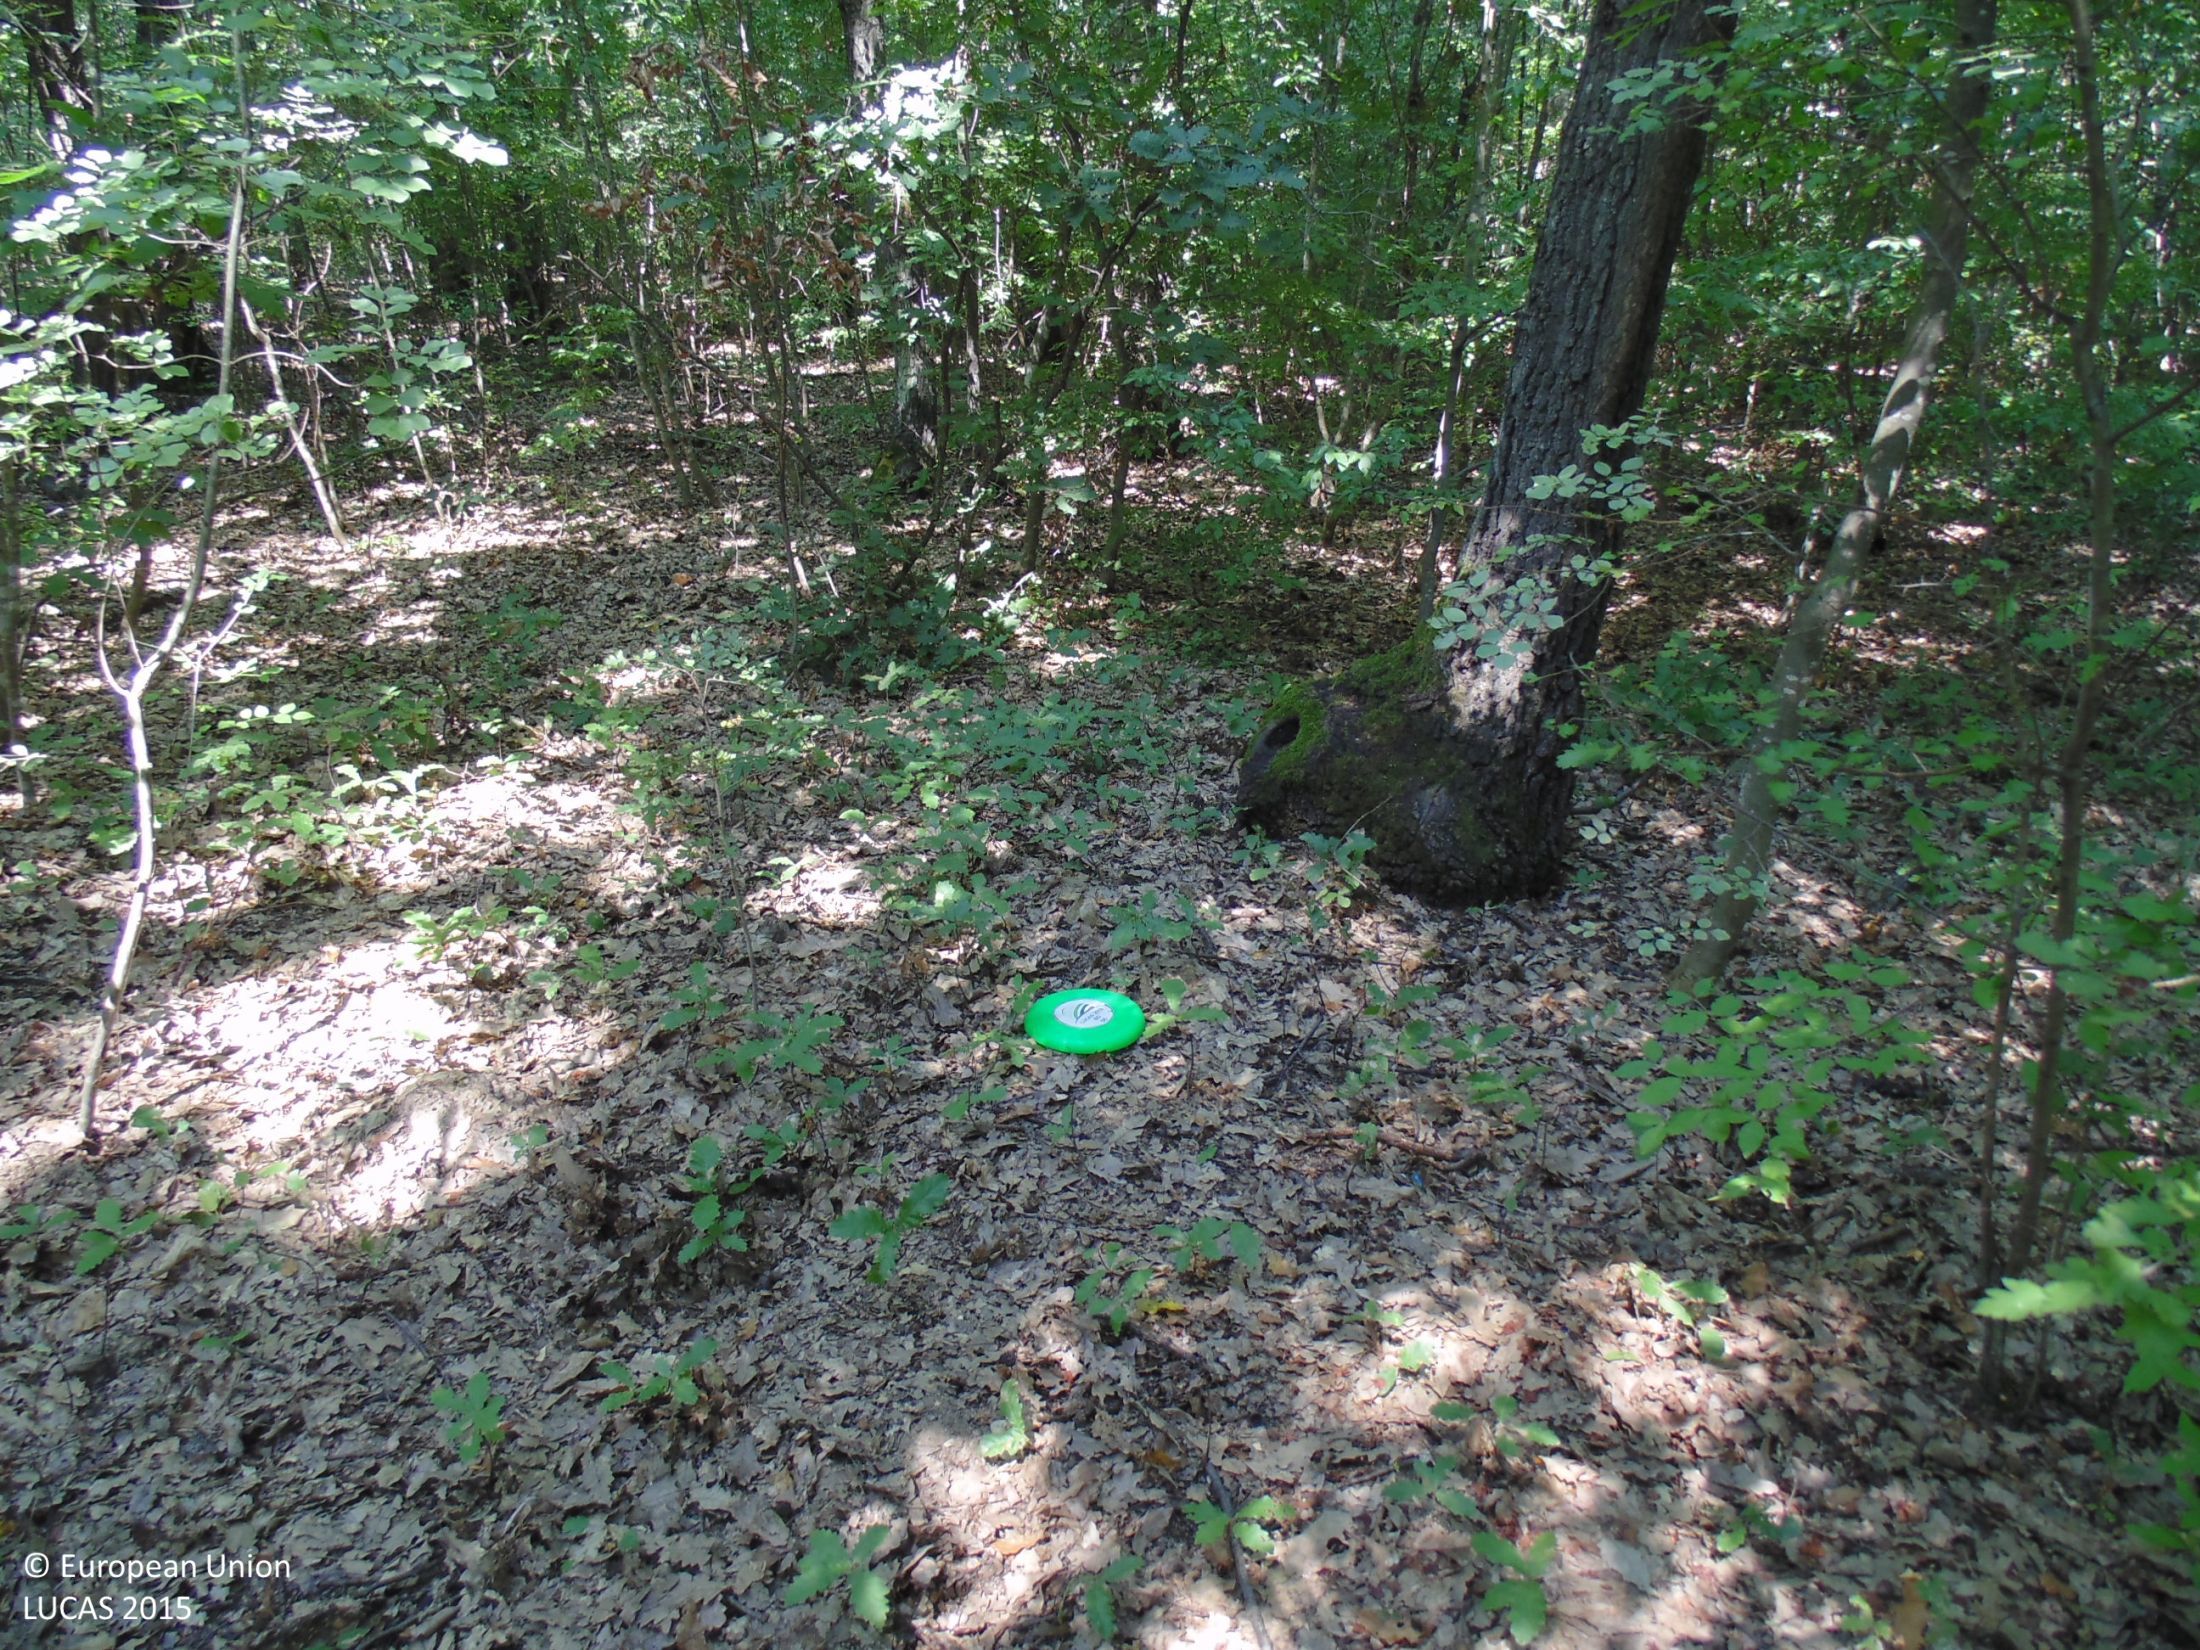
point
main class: Woodland
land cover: Broadleaved woodland
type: mesophytic deciduous forest
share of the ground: > 75 %
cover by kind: broadleaved forest trees 95 %, unconsolidated bare surface 5 %
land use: Forestry
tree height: > 5 m
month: August
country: BG
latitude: 43.9504
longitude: 27.4169
